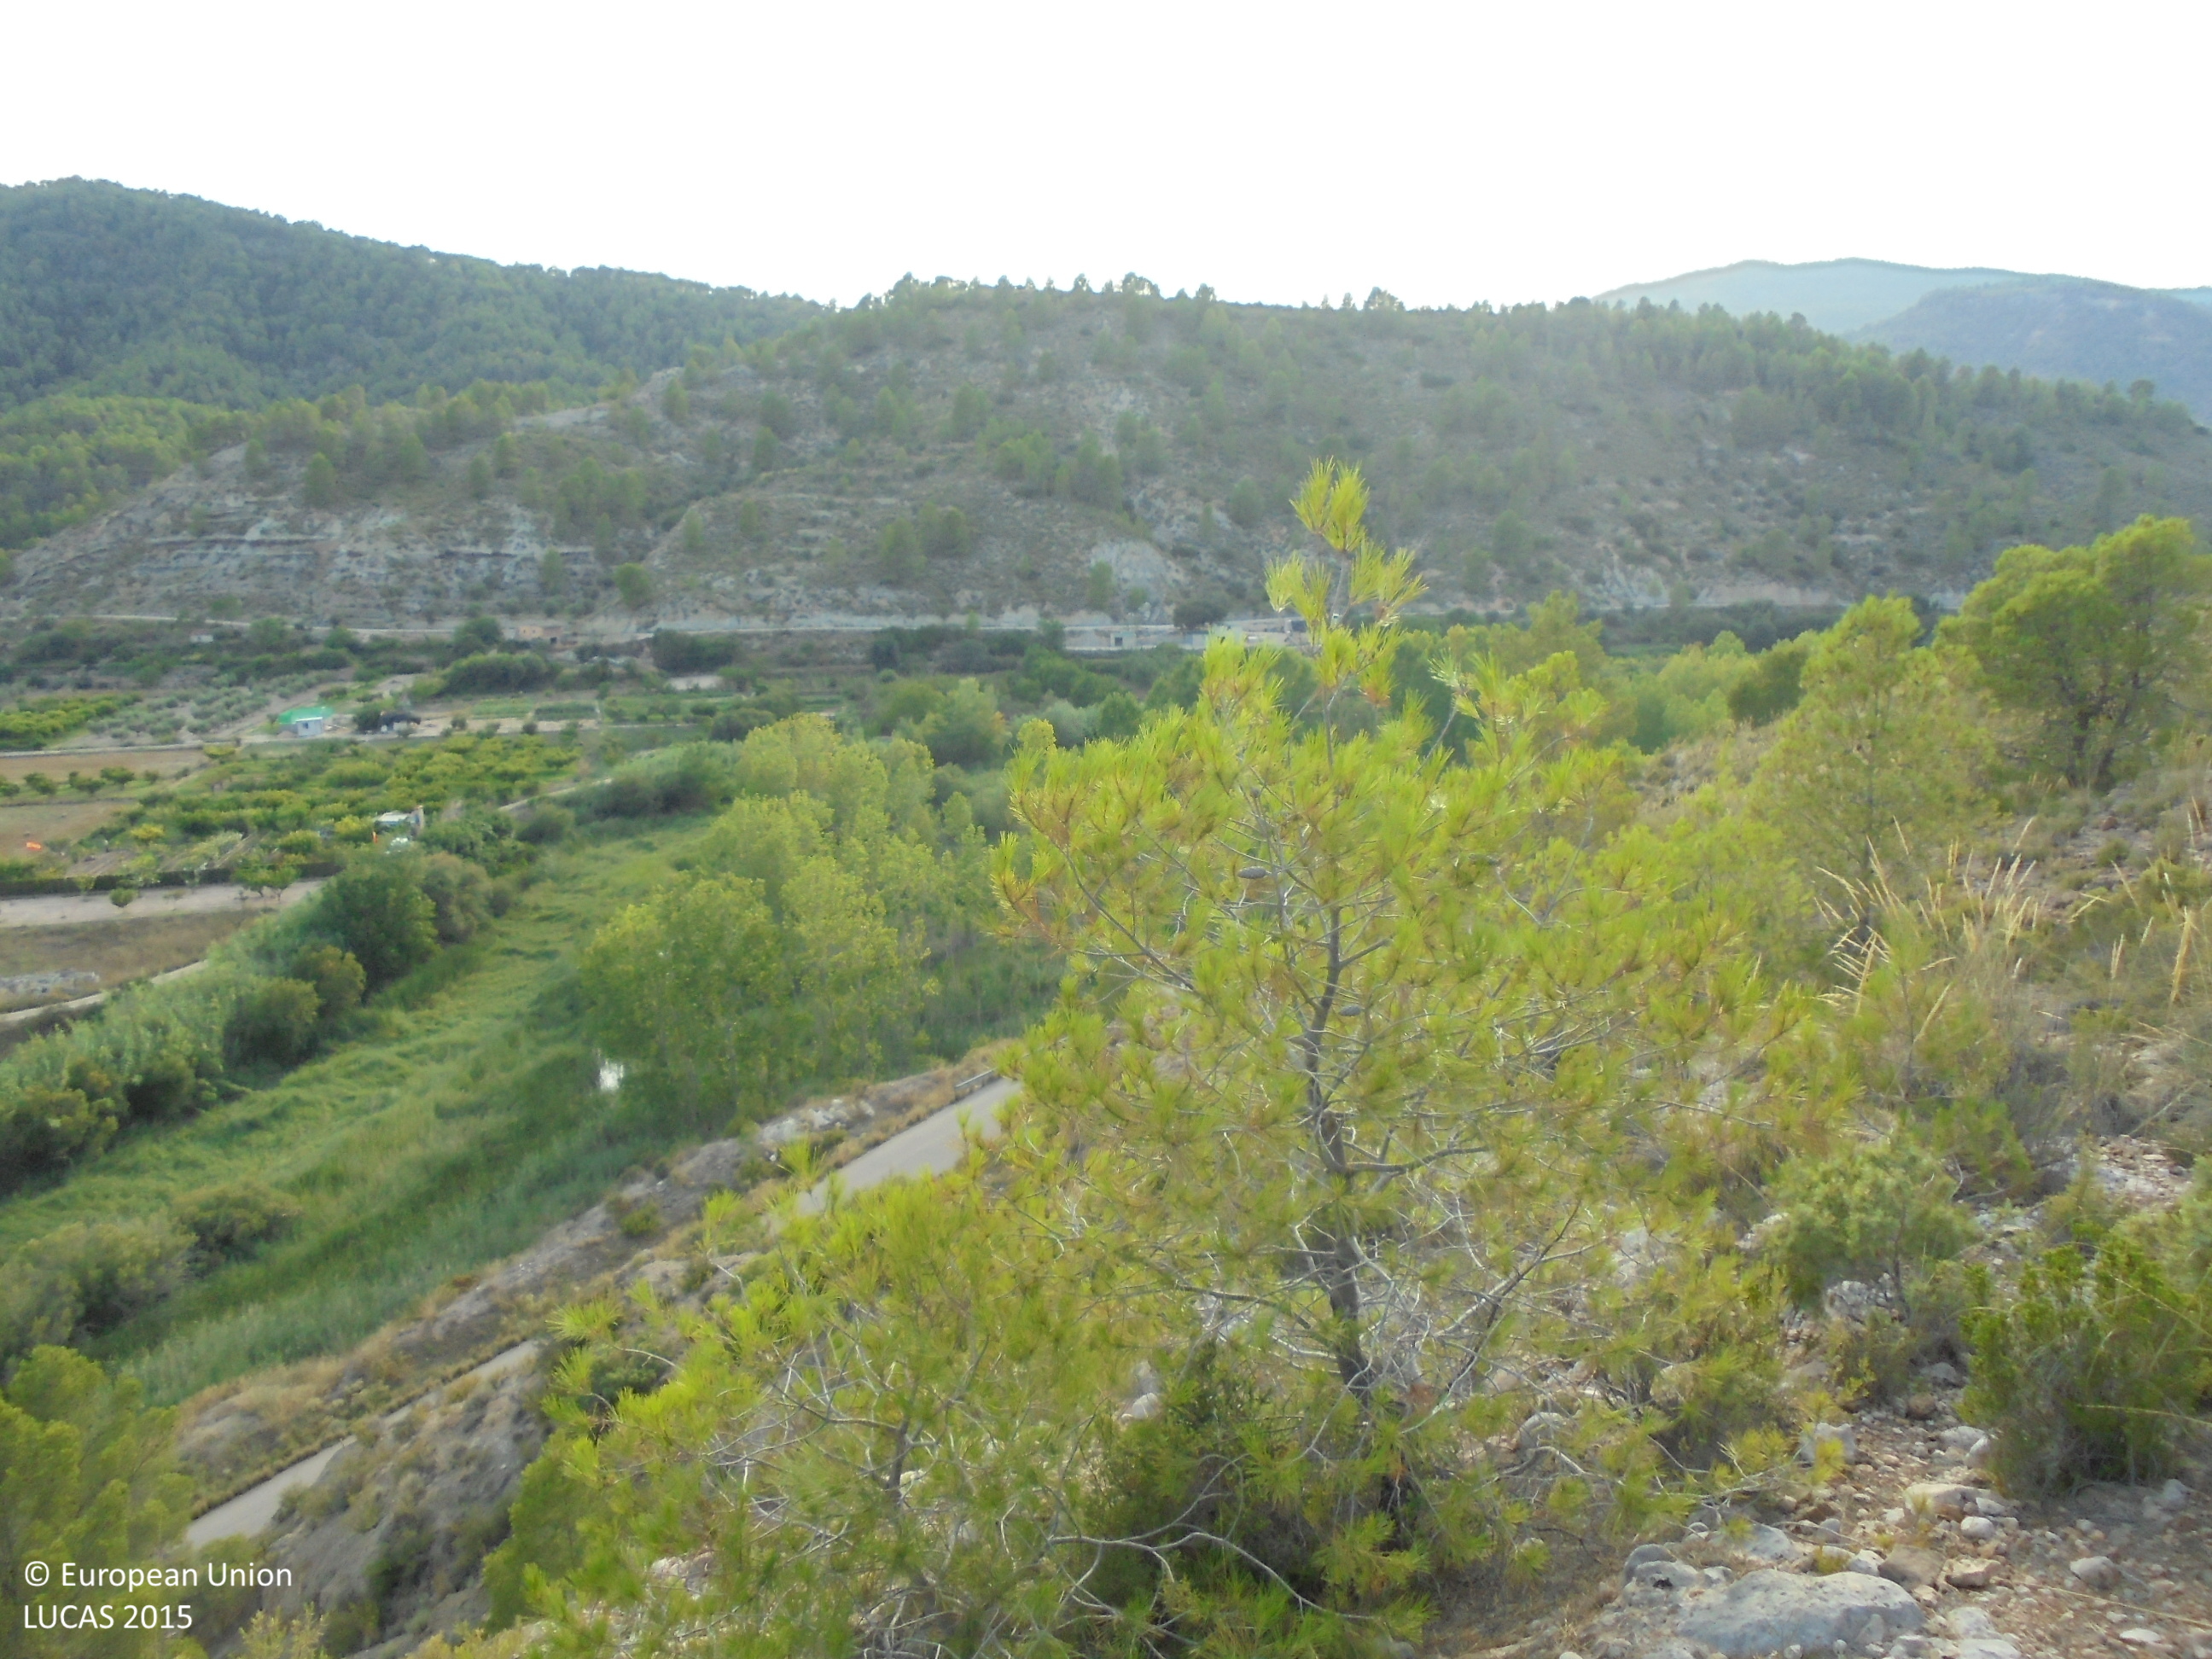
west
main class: Shrubland
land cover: Shrubland with sparse tree cover
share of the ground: > 75 %
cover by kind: shrubs 80 %, unconsolidated bare surface 15 %, coniferous forest trees 5 %
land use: Semi-natural and natural areas not in use
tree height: > 5 m
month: August
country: ES
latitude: 39.1997
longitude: -1.0793
